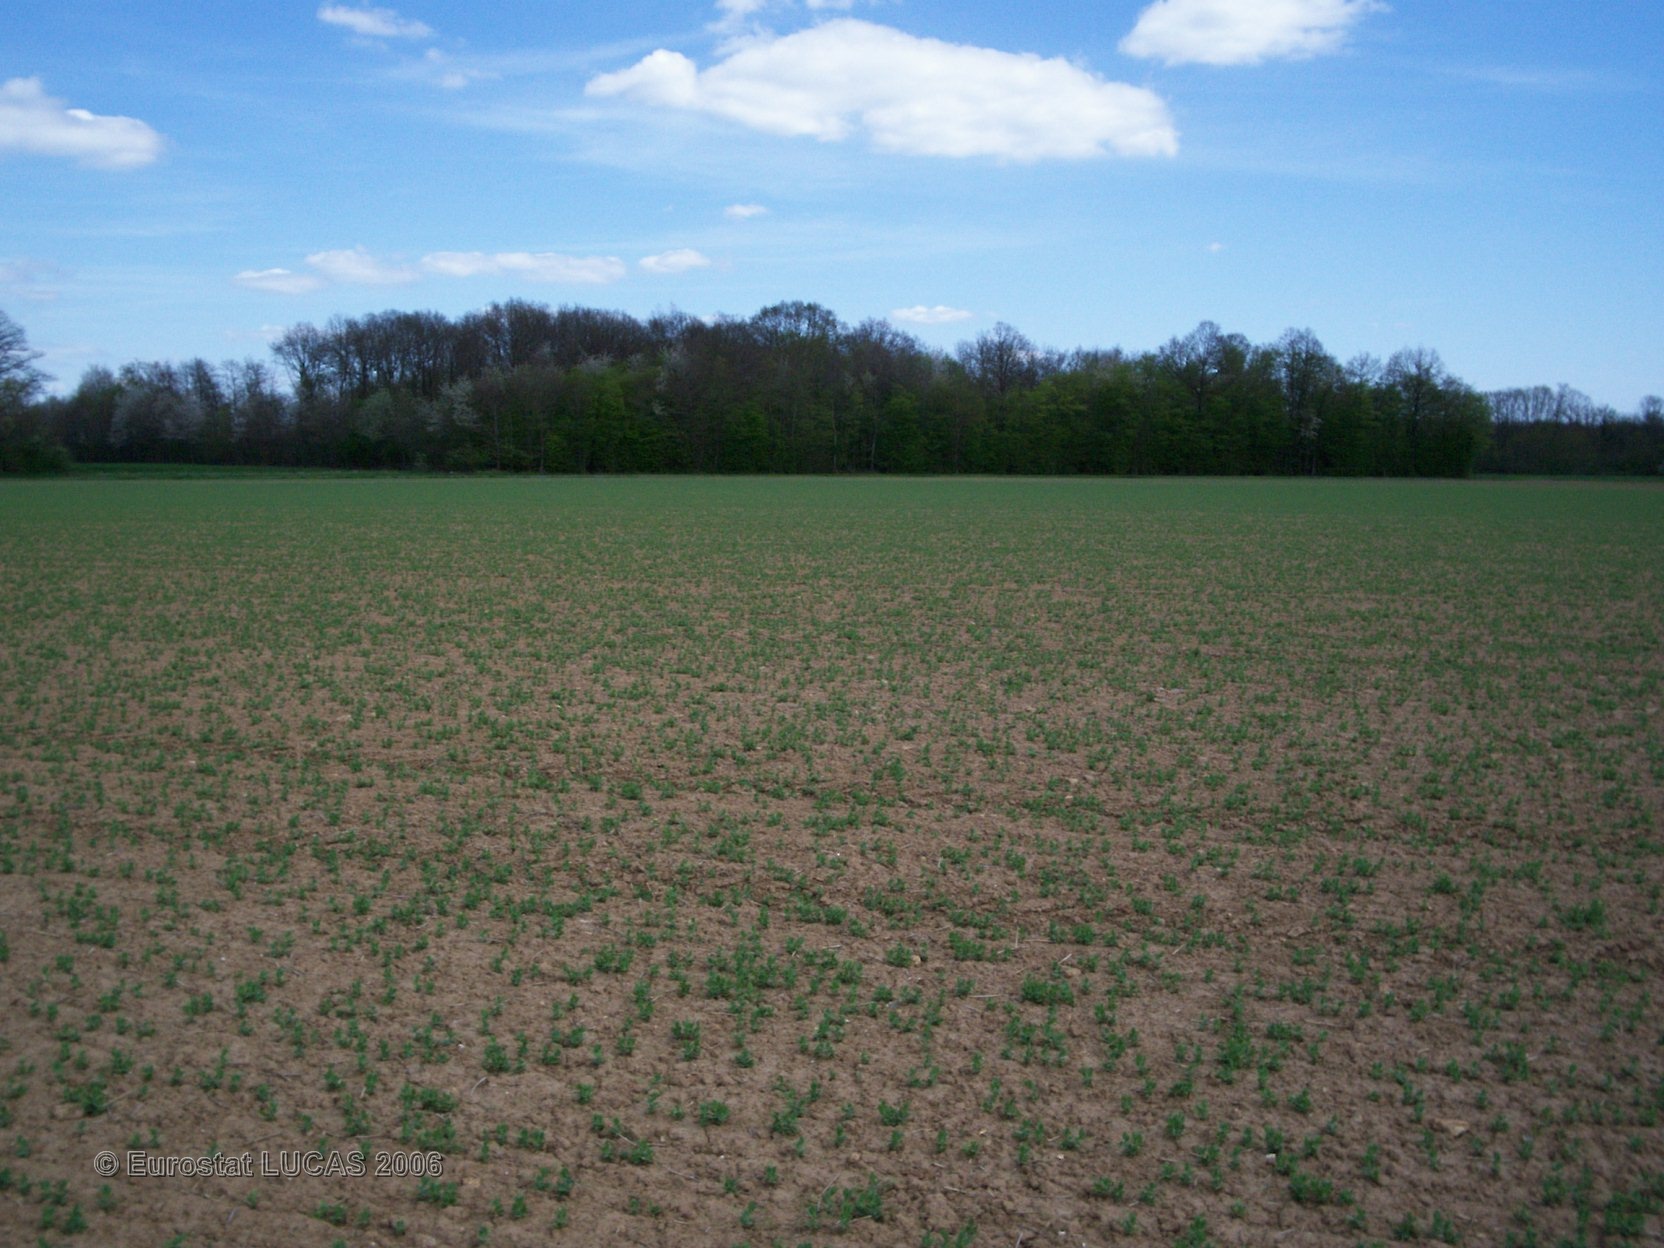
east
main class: Cropland
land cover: Dry pulses
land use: Agriculture (excluding fallow land and kitchen gardens)
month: April
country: FR
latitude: 48.9260
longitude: 1.0390
